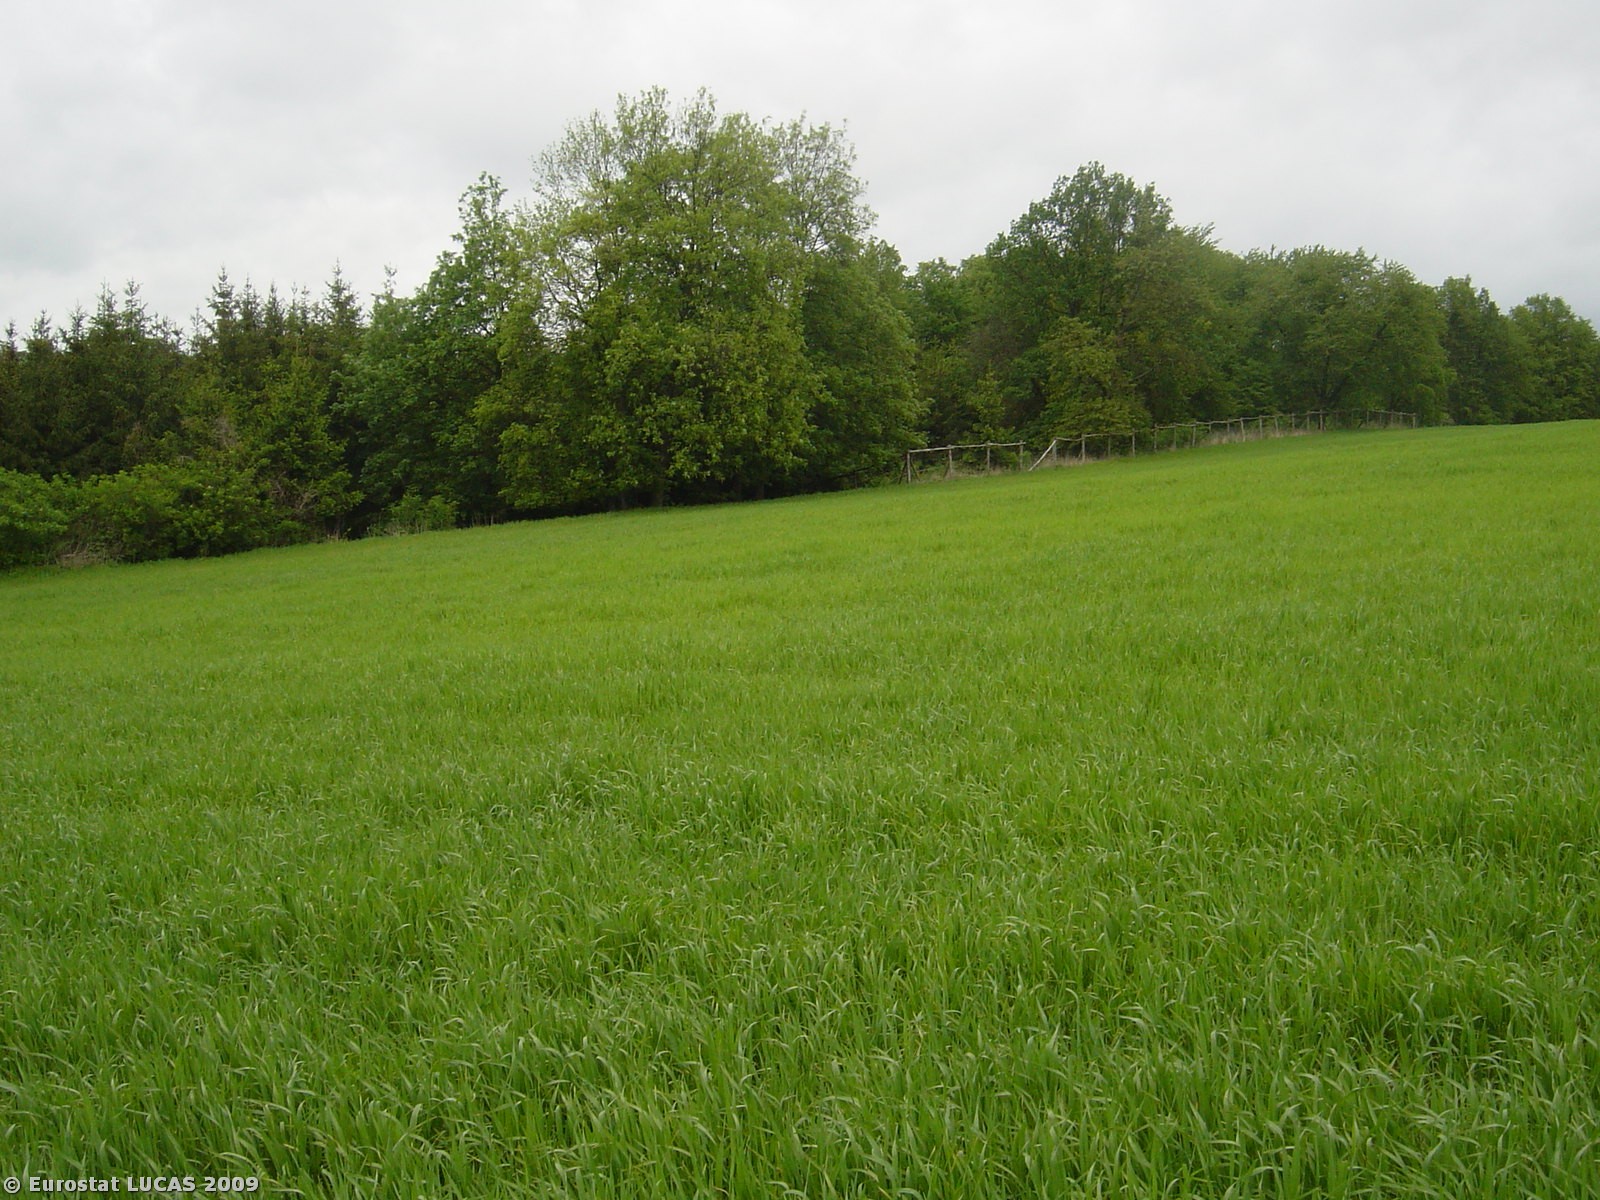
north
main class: Cropland
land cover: Barley
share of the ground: > 75 %
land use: Agriculture (excluding fallow land and kitchen gardens)
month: May
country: CZ
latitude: 49.2439
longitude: 16.4490
